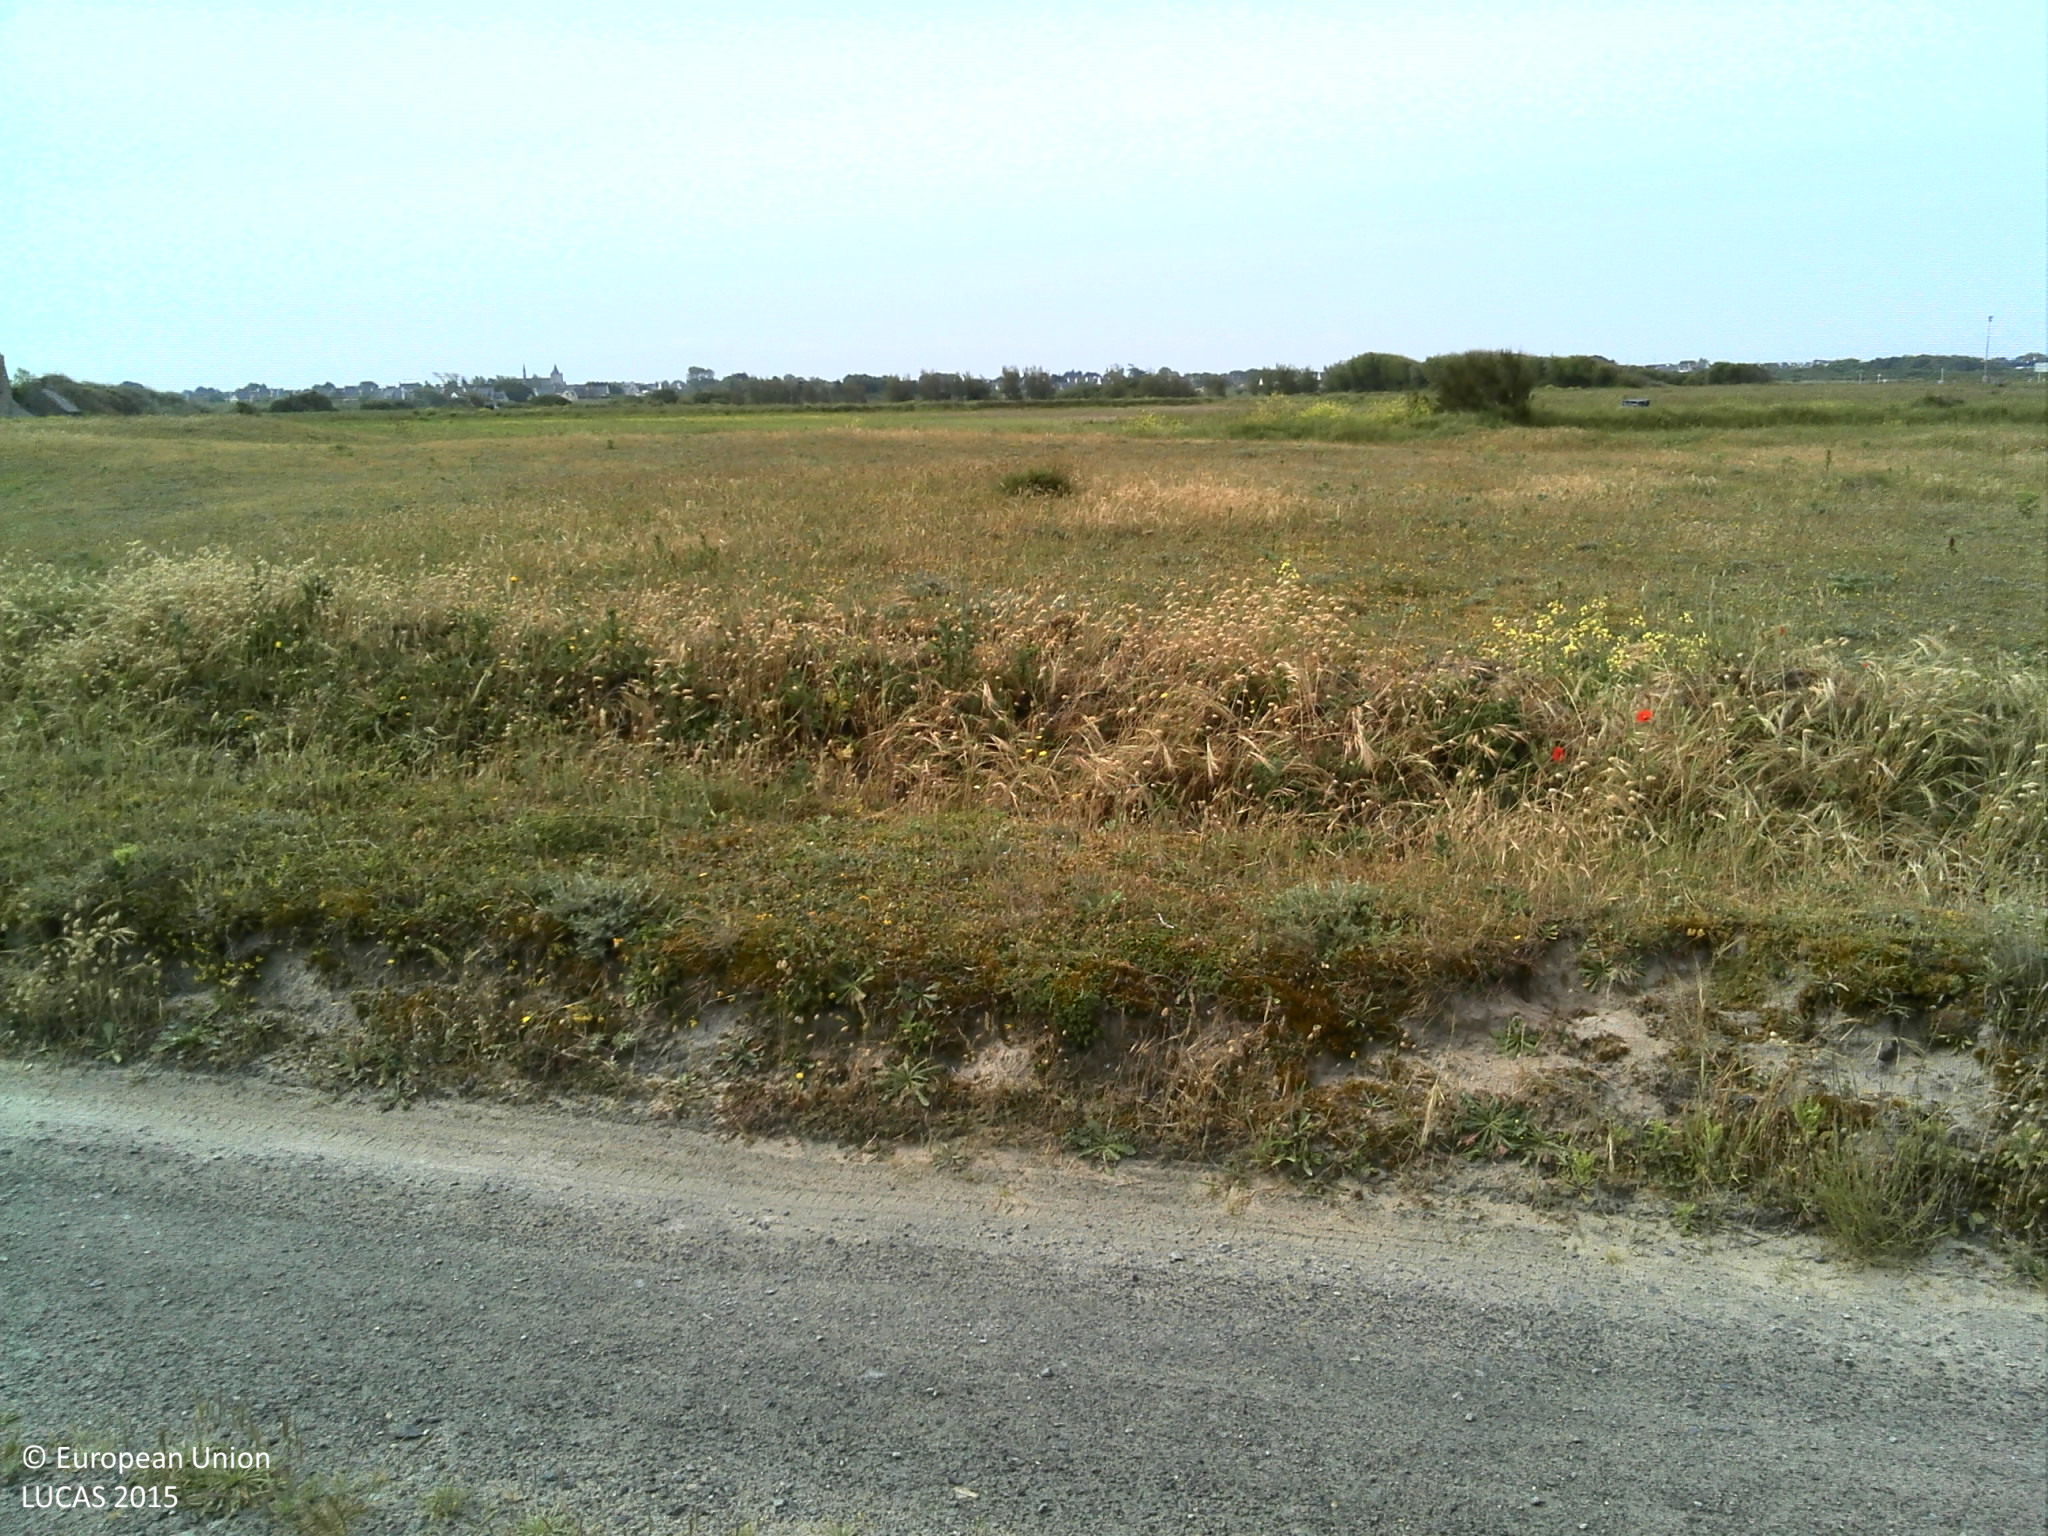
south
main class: Grassland
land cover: Grassland without tree/shrub cover
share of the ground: > 75 %
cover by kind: herbaceous plants 100 %
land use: Agriculture (excluding fallow land and kitchen gardens)
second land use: Amenities, museums, leisure
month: June
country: FR
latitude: 47.8273
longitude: -4.3454
